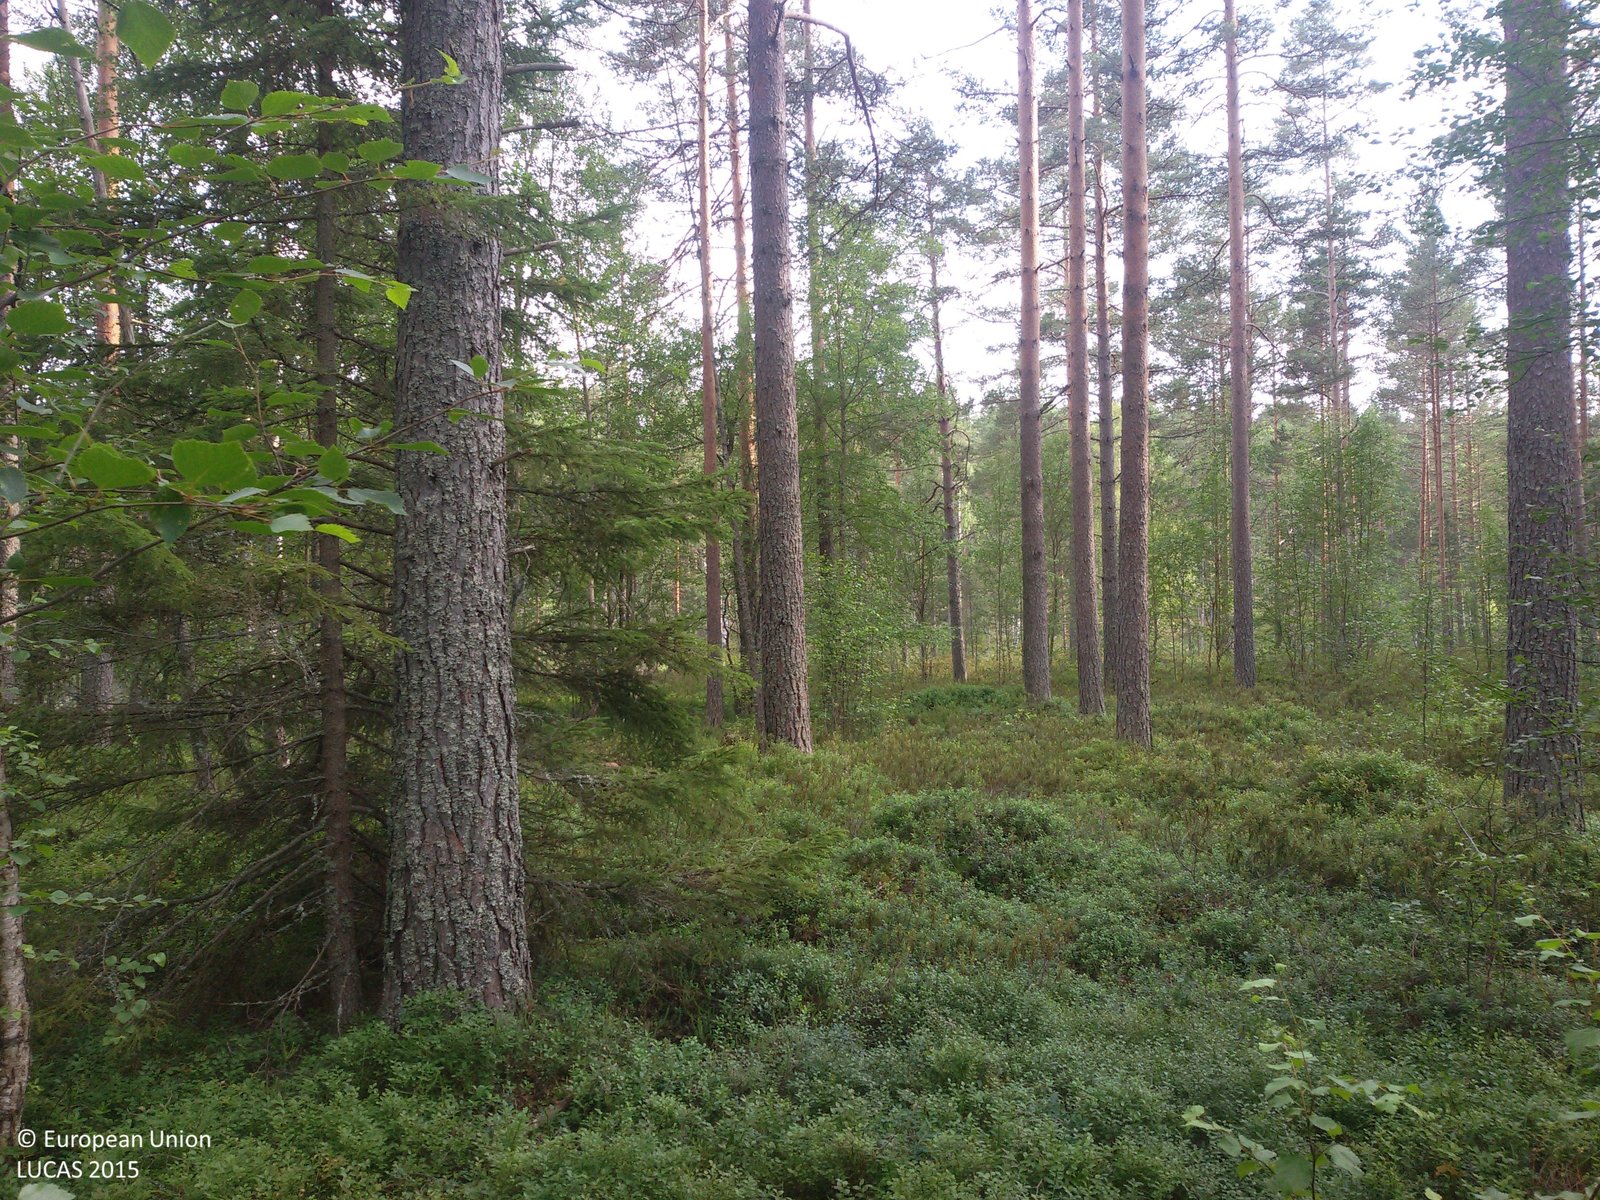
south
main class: Woodland
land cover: Pine dominated mixed woodland
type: boreal forest
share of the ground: > 75 %
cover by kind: coniferous forest trees 50 %, broadleaved forest trees 30 %, shrubs 20 %
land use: Forestry
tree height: > 5 m
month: July
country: SE
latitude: 60.5249
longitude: 15.9456
